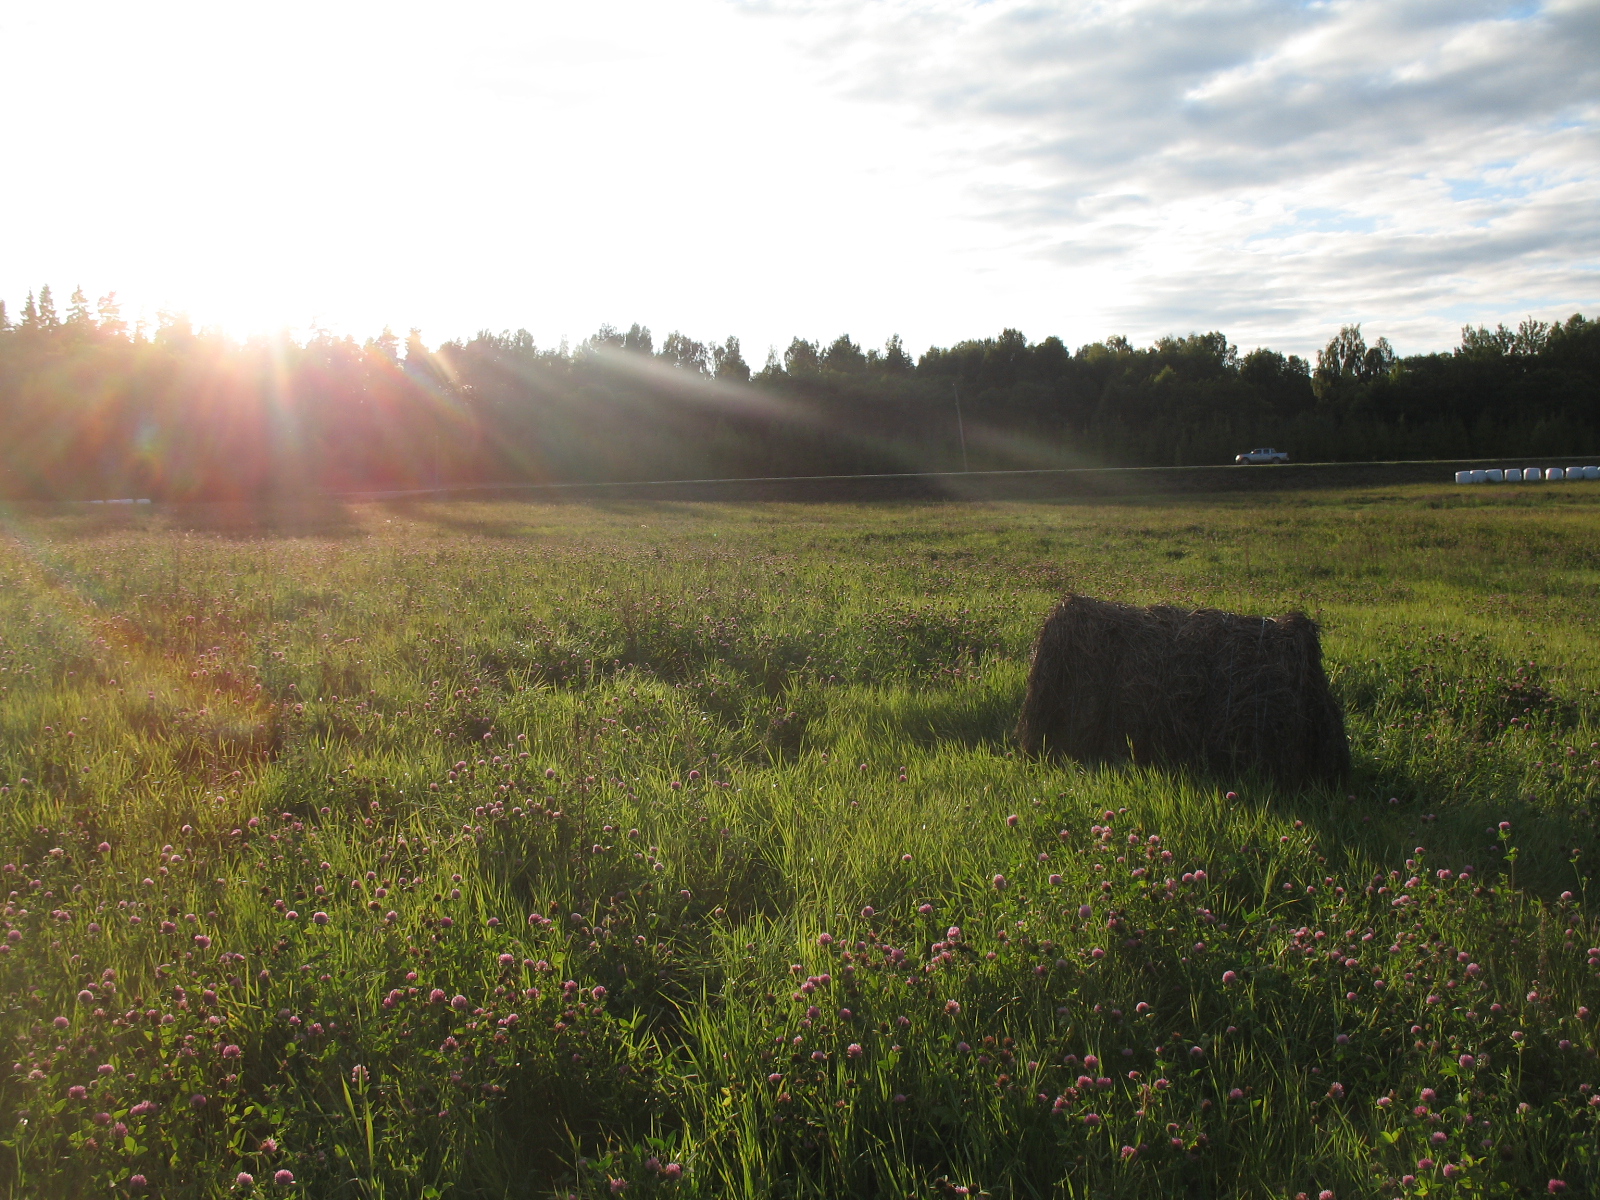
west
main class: Grassland
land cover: Grassland without tree/shrub cover
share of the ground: > 75 %
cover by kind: herbaceous plants 100 %
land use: Agriculture (excluding fallow land and kitchen gardens)
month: September
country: LV
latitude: 56.1768
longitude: 25.7701
